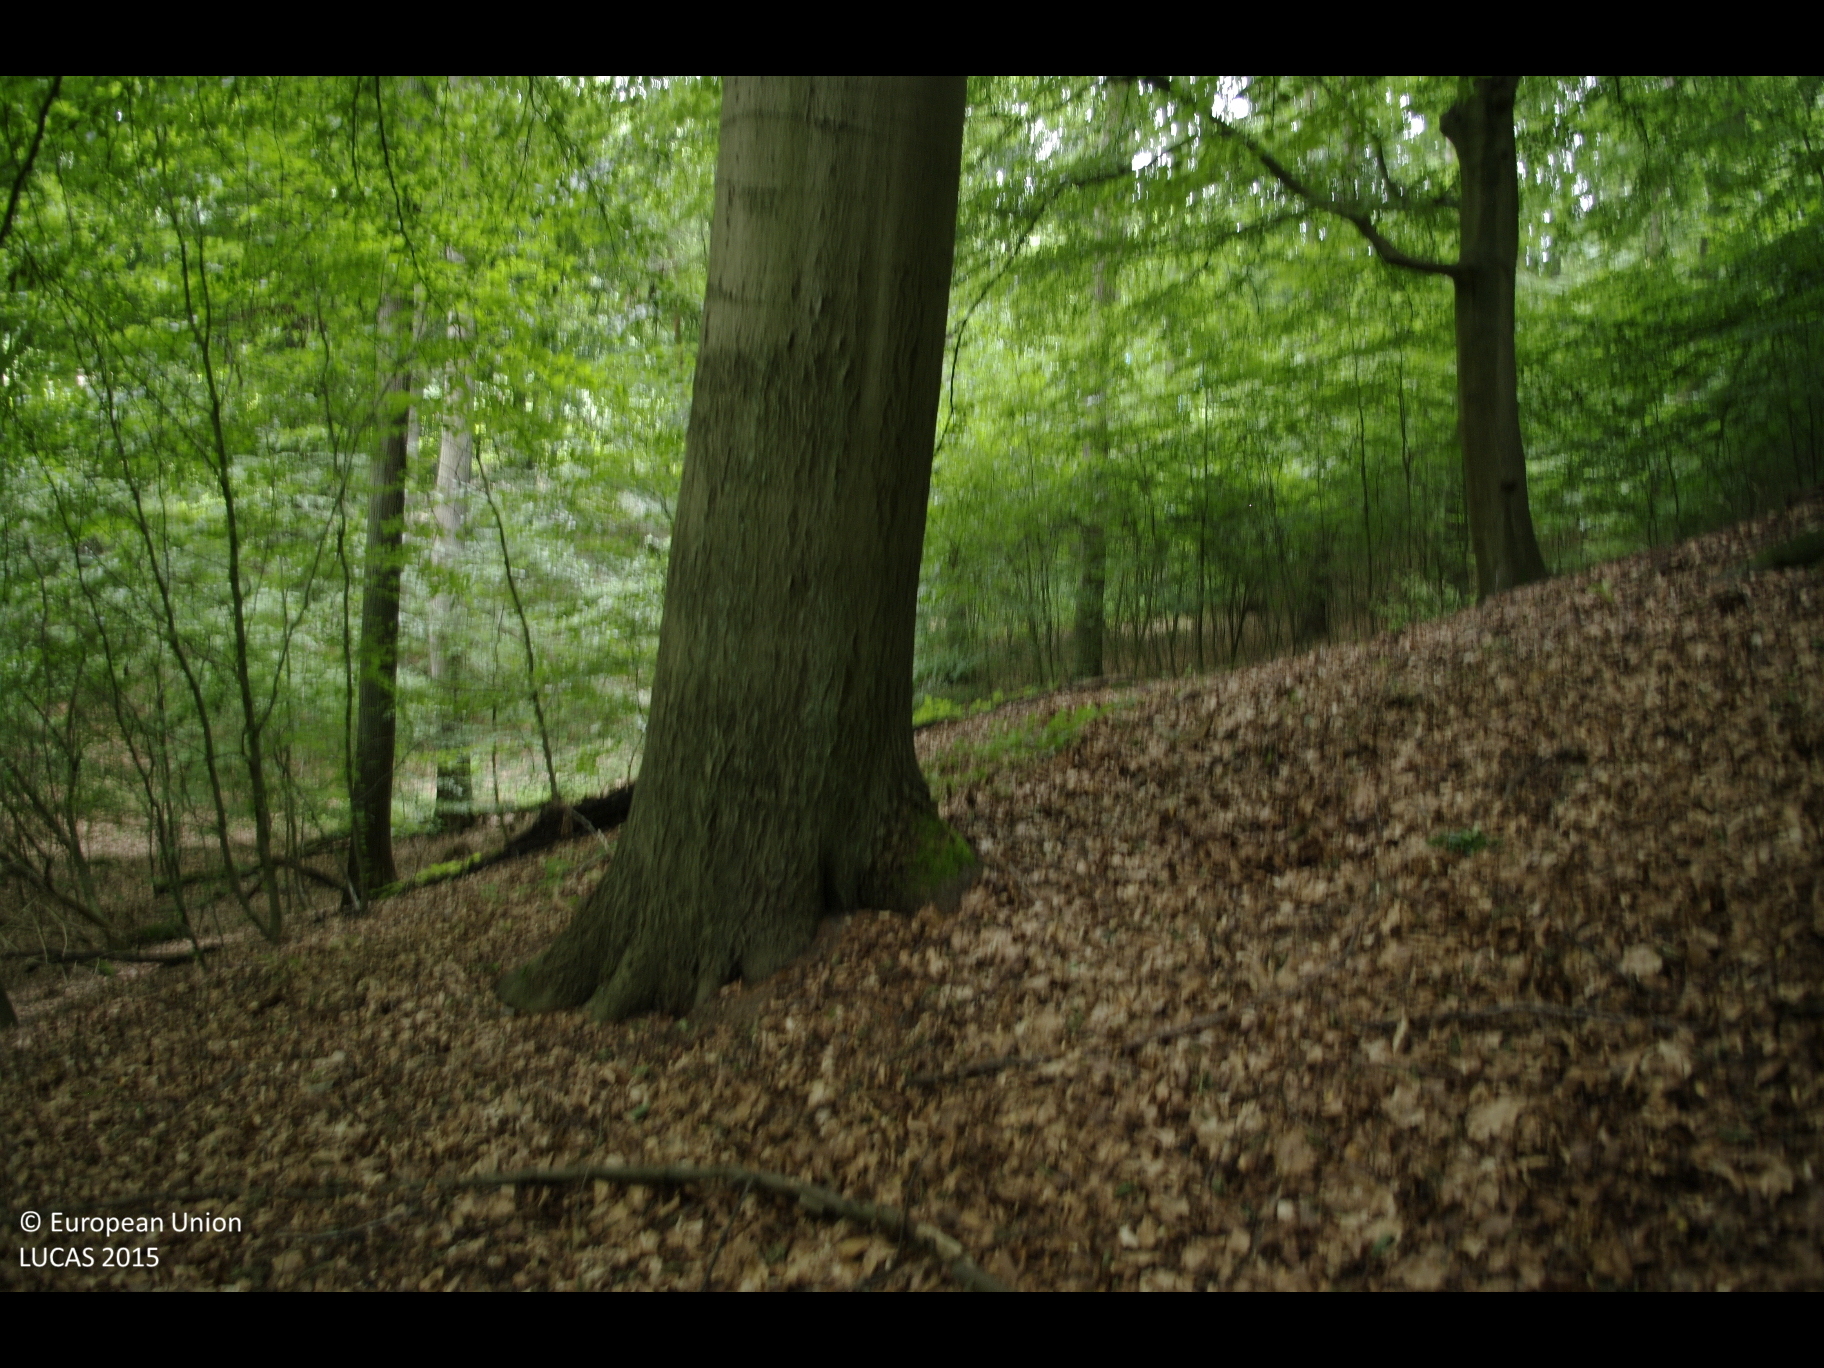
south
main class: Woodland
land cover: Broadleaved woodland
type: mesophytic deciduous forest
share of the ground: > 75 %
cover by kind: broadleaved forest trees 90 %, herbaceous plants 5 %, unconsolidated bare surface 5 %
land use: Forestry
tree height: > 5 m
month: July
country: DE
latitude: 53.4558
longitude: 9.9247
